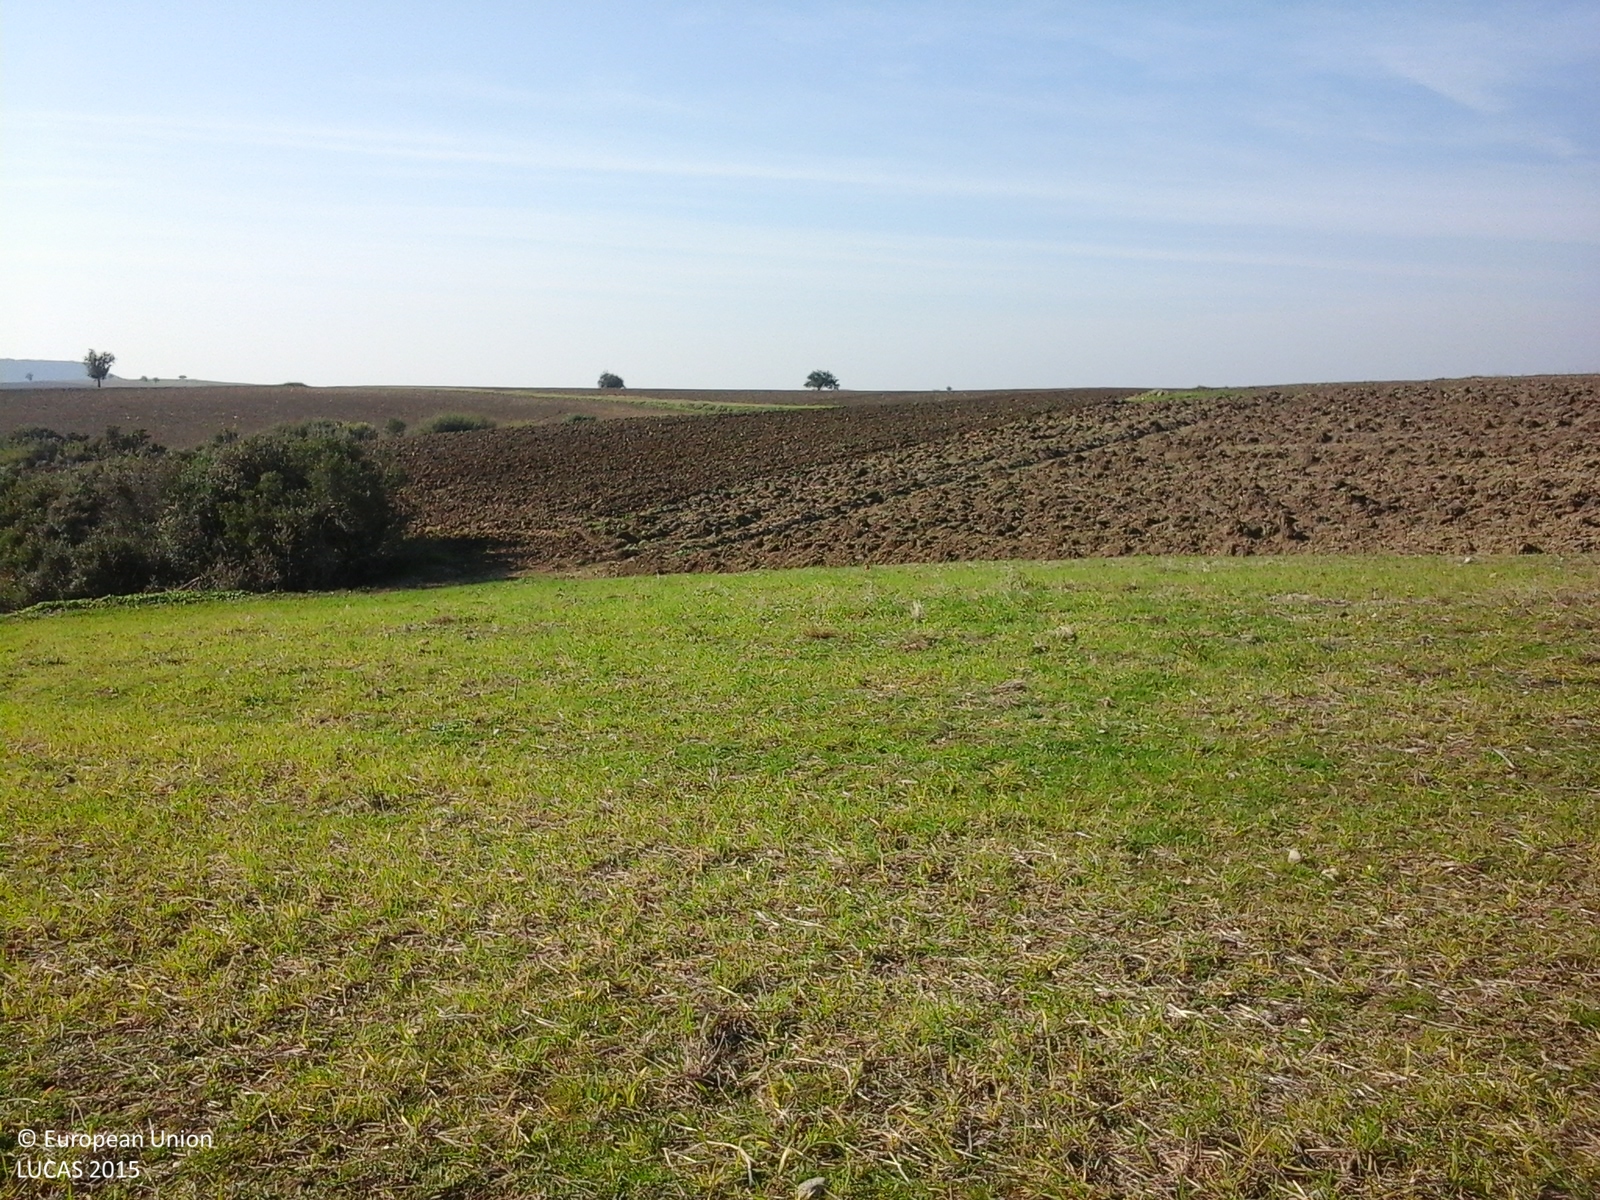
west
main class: Grassland
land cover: Spontaneously vegetated surfaces
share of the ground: > 75 %
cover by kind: herbaceous plants 100 %
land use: Agriculture (excluding fallow land and kitchen gardens)
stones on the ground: < 10 %
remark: Harvested field
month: November
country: GR
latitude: 40.4036
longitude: 23.1447
